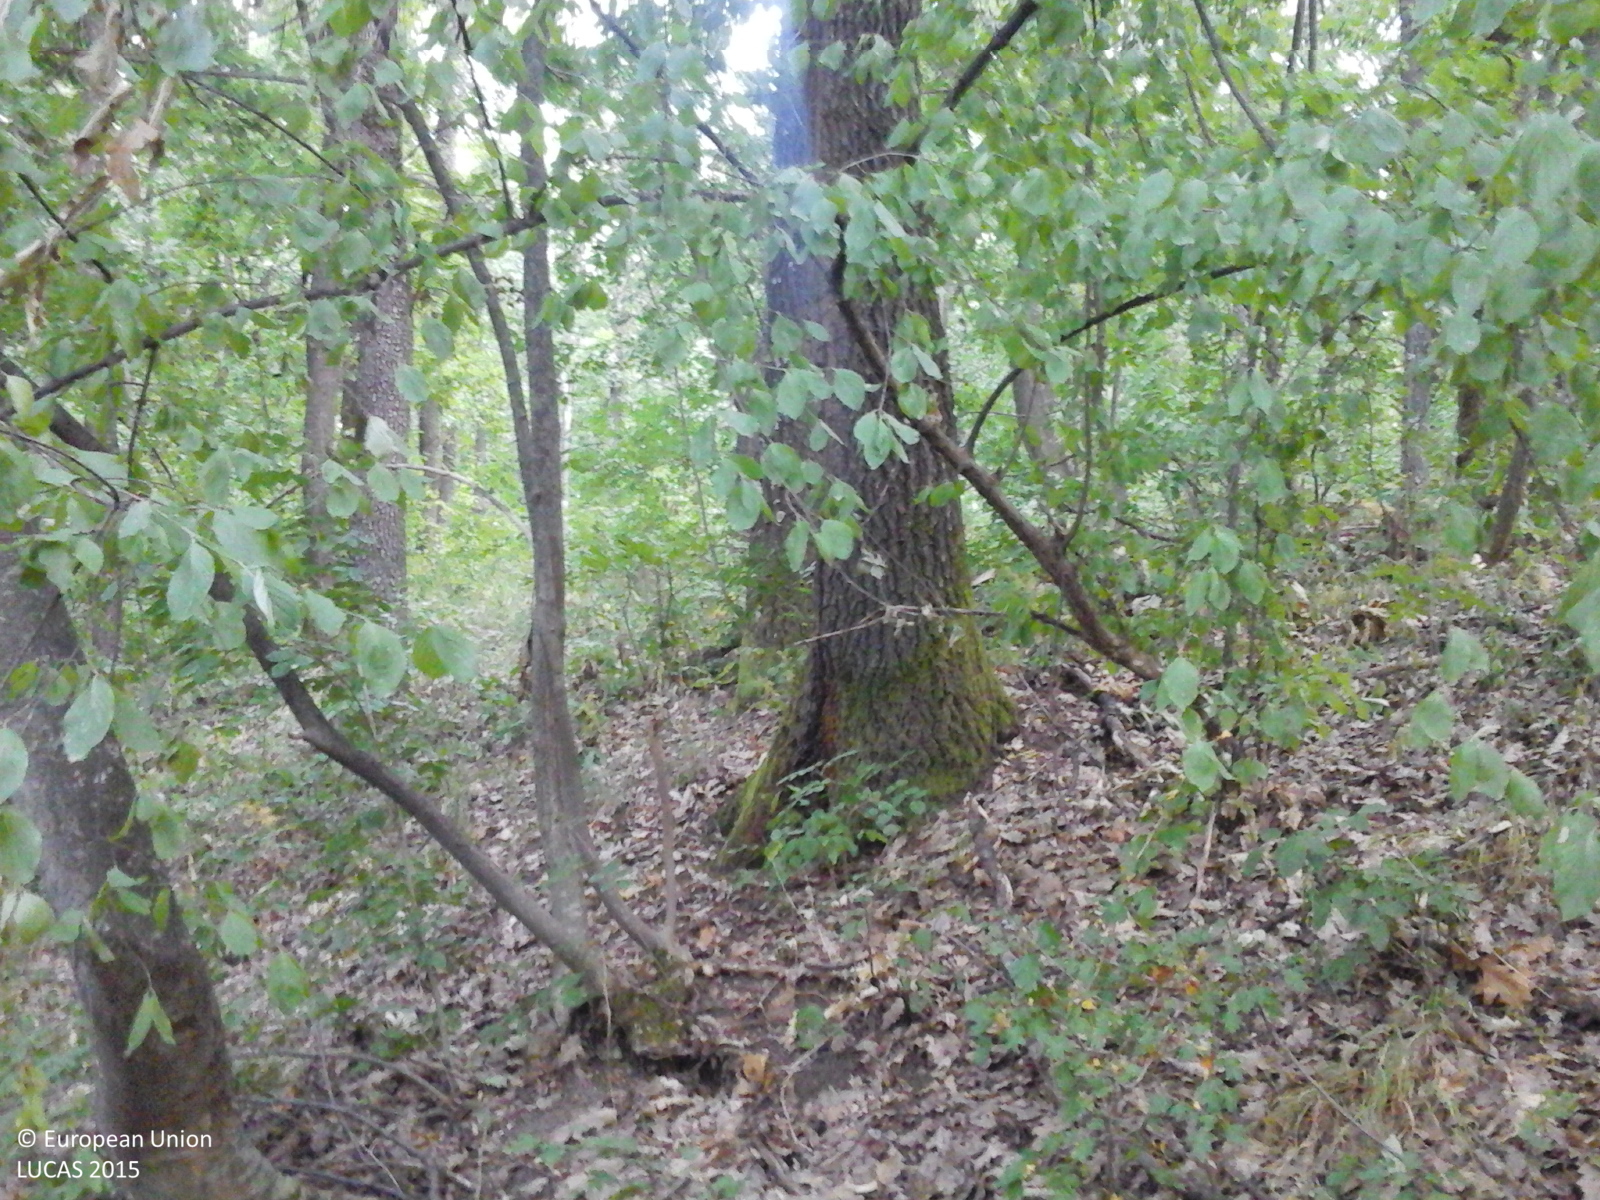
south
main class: Woodland
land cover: Broadleaved woodland
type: acidophilous oak and oak-birch forest
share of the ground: > 75 %
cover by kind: broadleaved forest trees 100 %
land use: Forestry
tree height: > 5 m
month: August
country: RO
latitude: 44.5643
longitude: 23.1810
